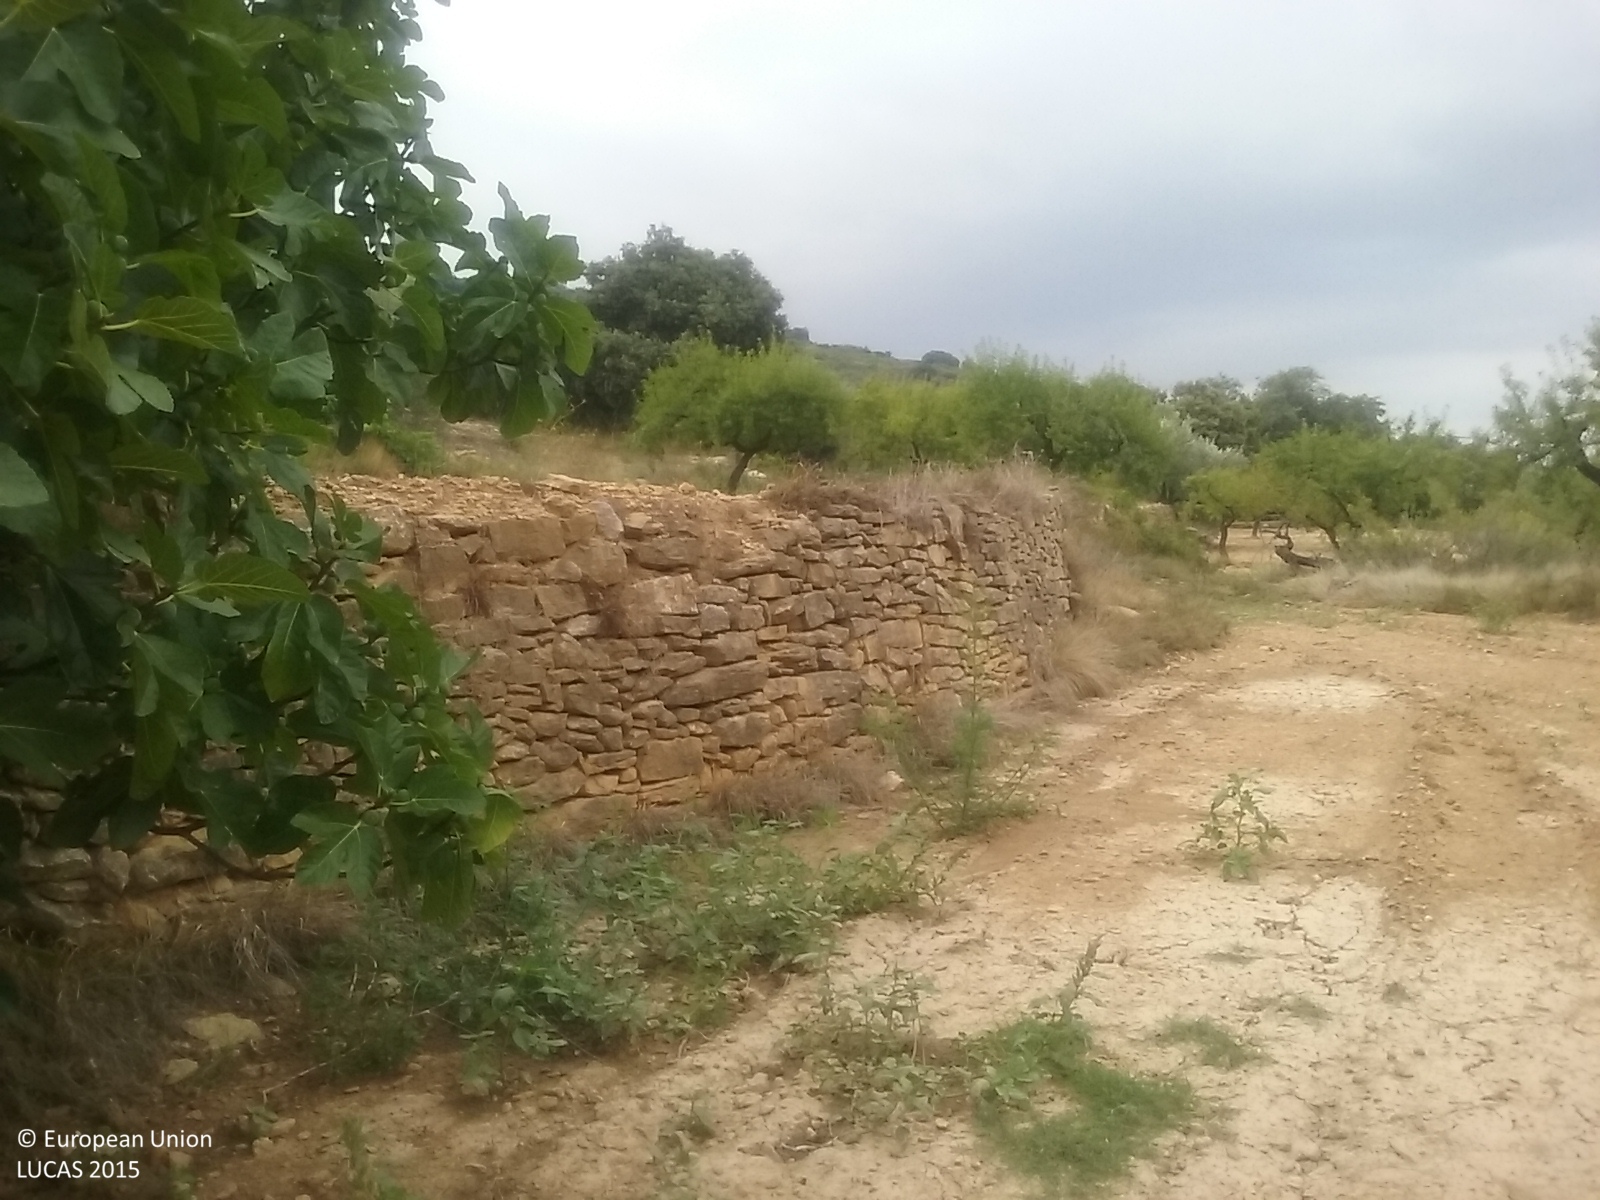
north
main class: Cropland
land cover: Nuts trees
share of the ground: 50 - 75 %
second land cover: Spontaneously vegetated surfaces
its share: 10 - 25 %
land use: Agriculture (excluding fallow land and kitchen gardens)
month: August
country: ES
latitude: 40.3108
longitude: -0.0885
